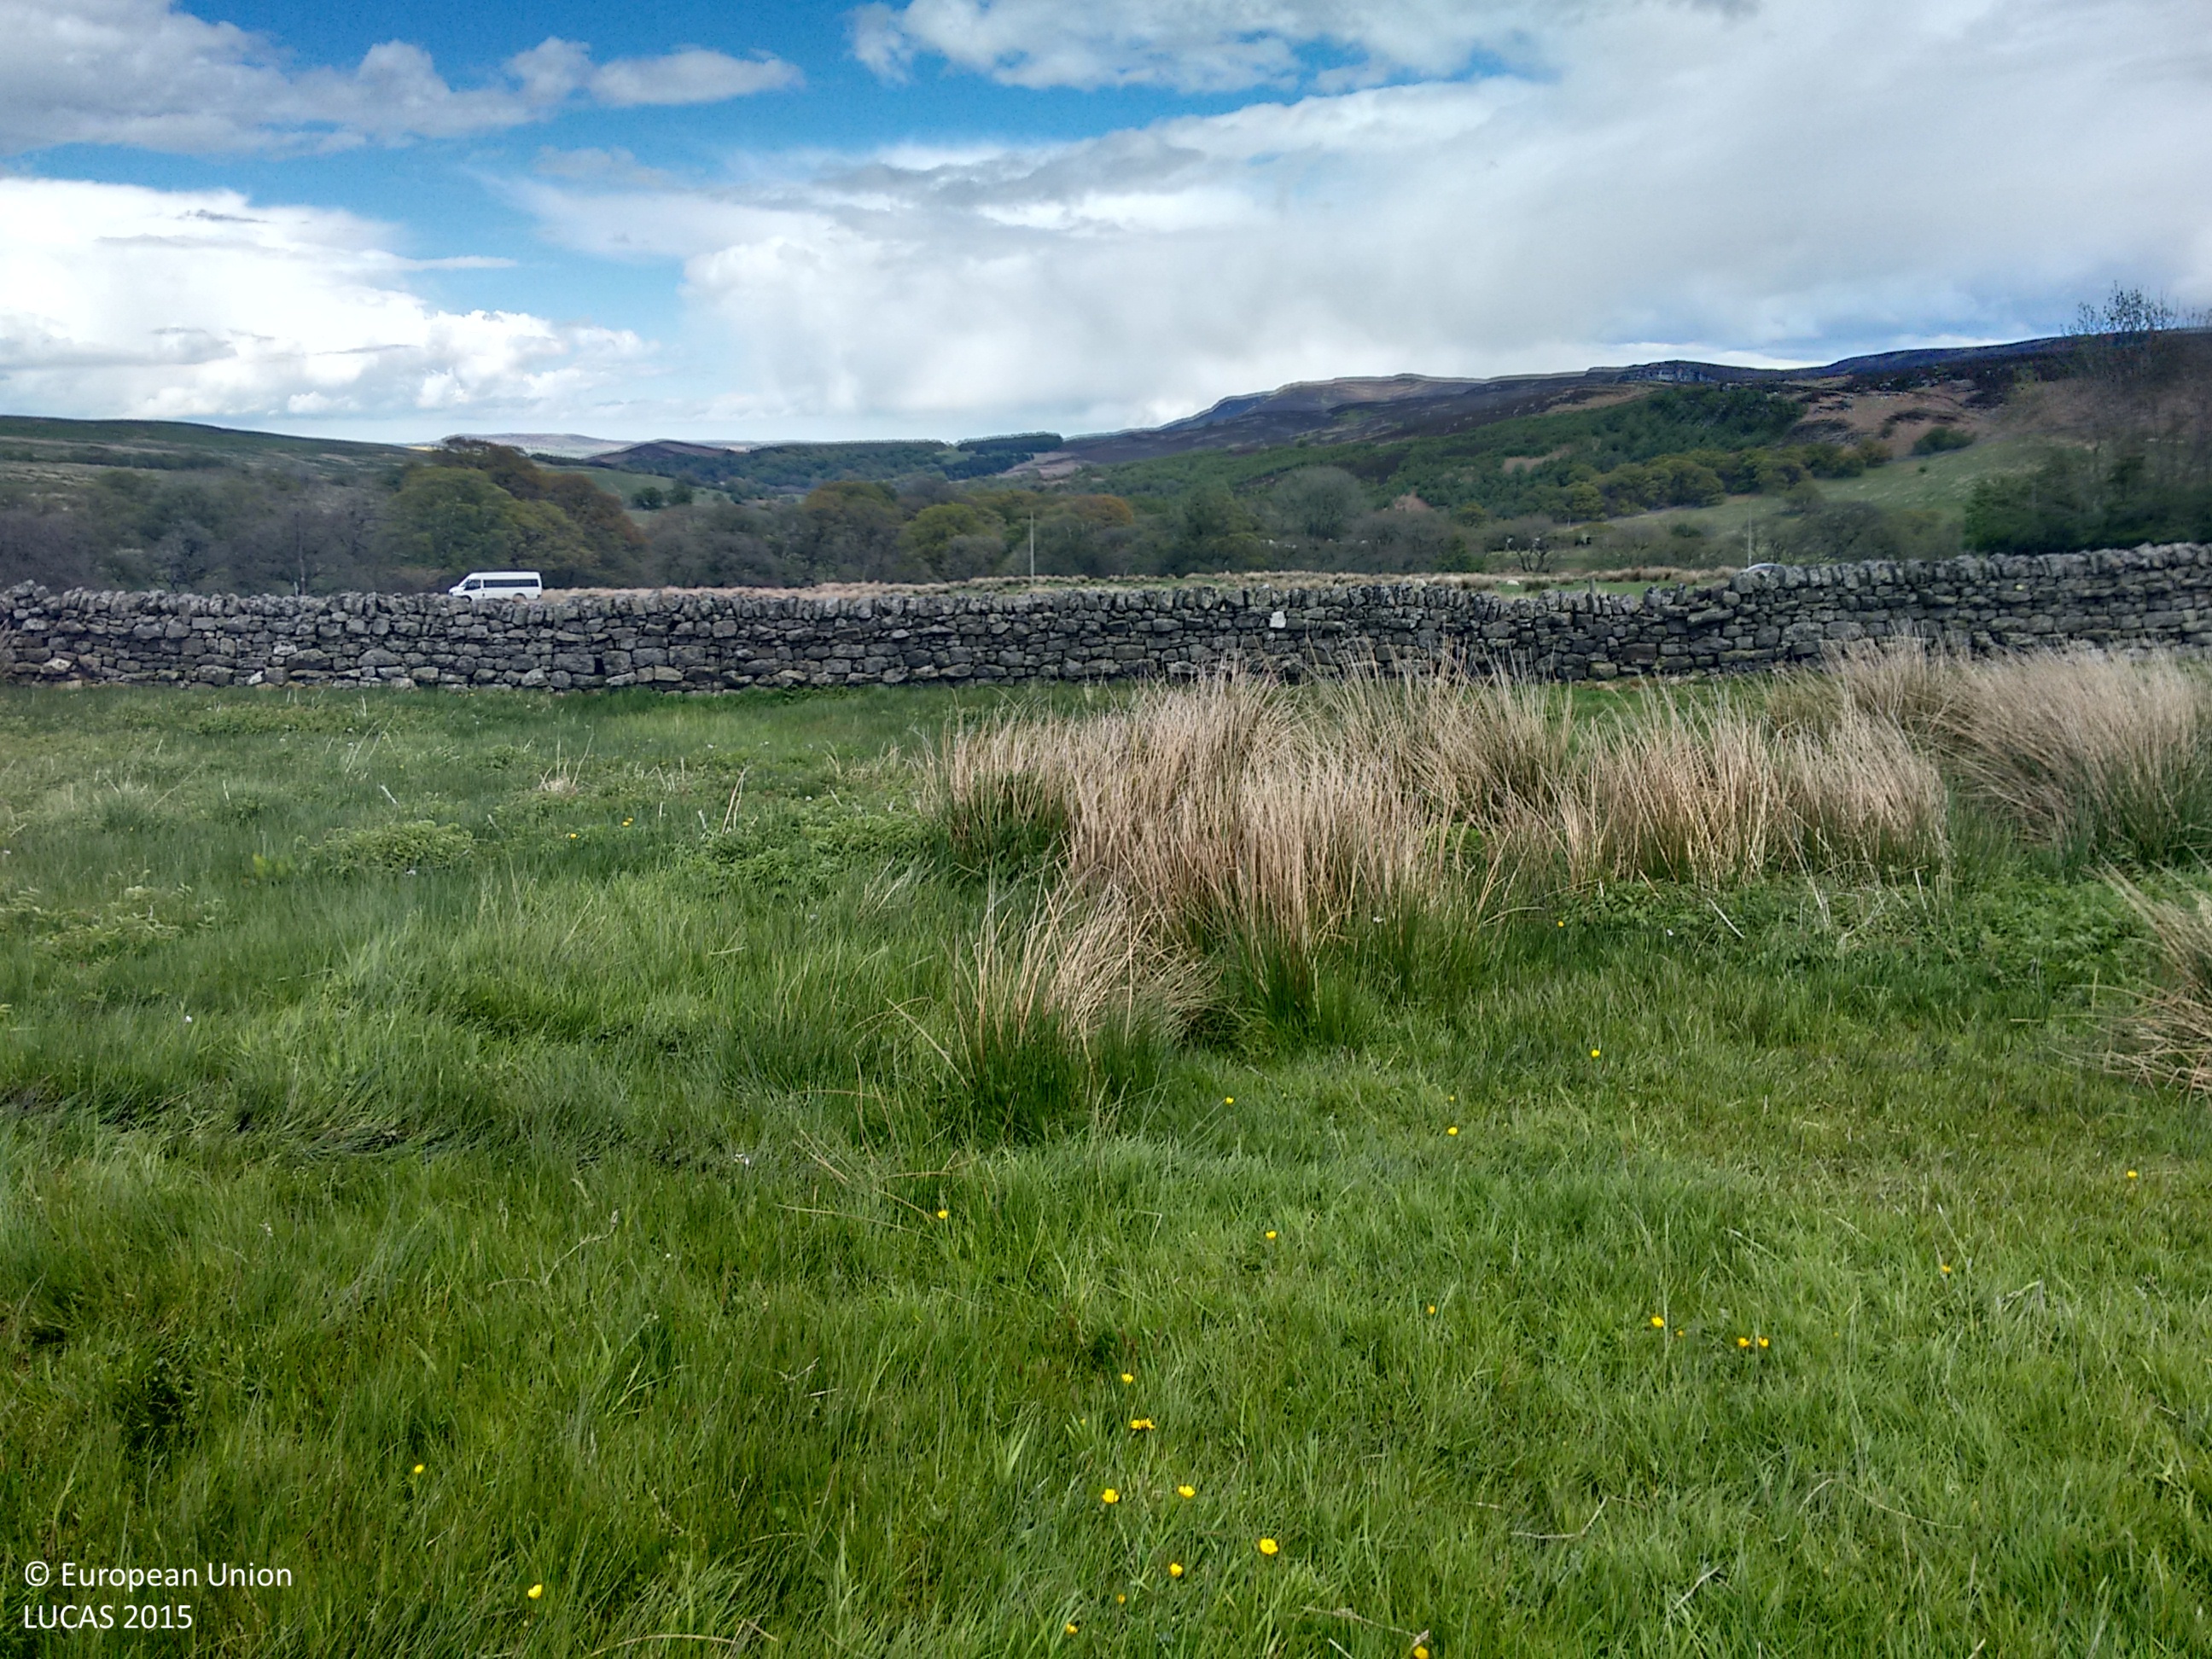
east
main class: Grassland
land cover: Grassland without tree/shrub cover
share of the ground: > 75 %
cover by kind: herbaceous plants 100 %
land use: Agriculture (excluding fallow land and kitchen gardens)
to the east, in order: Grassland without tree/shrub cover; Dry stone walls; Grassland without tree/shrub cover; Paved roads, cycling and walking lanes; Electric lines; Grassland without tree/shrub cover; Broadleaved woodland; Rivers and streams; Broadleaved woodland; Grassland without tree/shrub cover; Fences; Grassland without tree/shrub cover
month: May
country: GB
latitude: 55.2673
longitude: -2.0948
